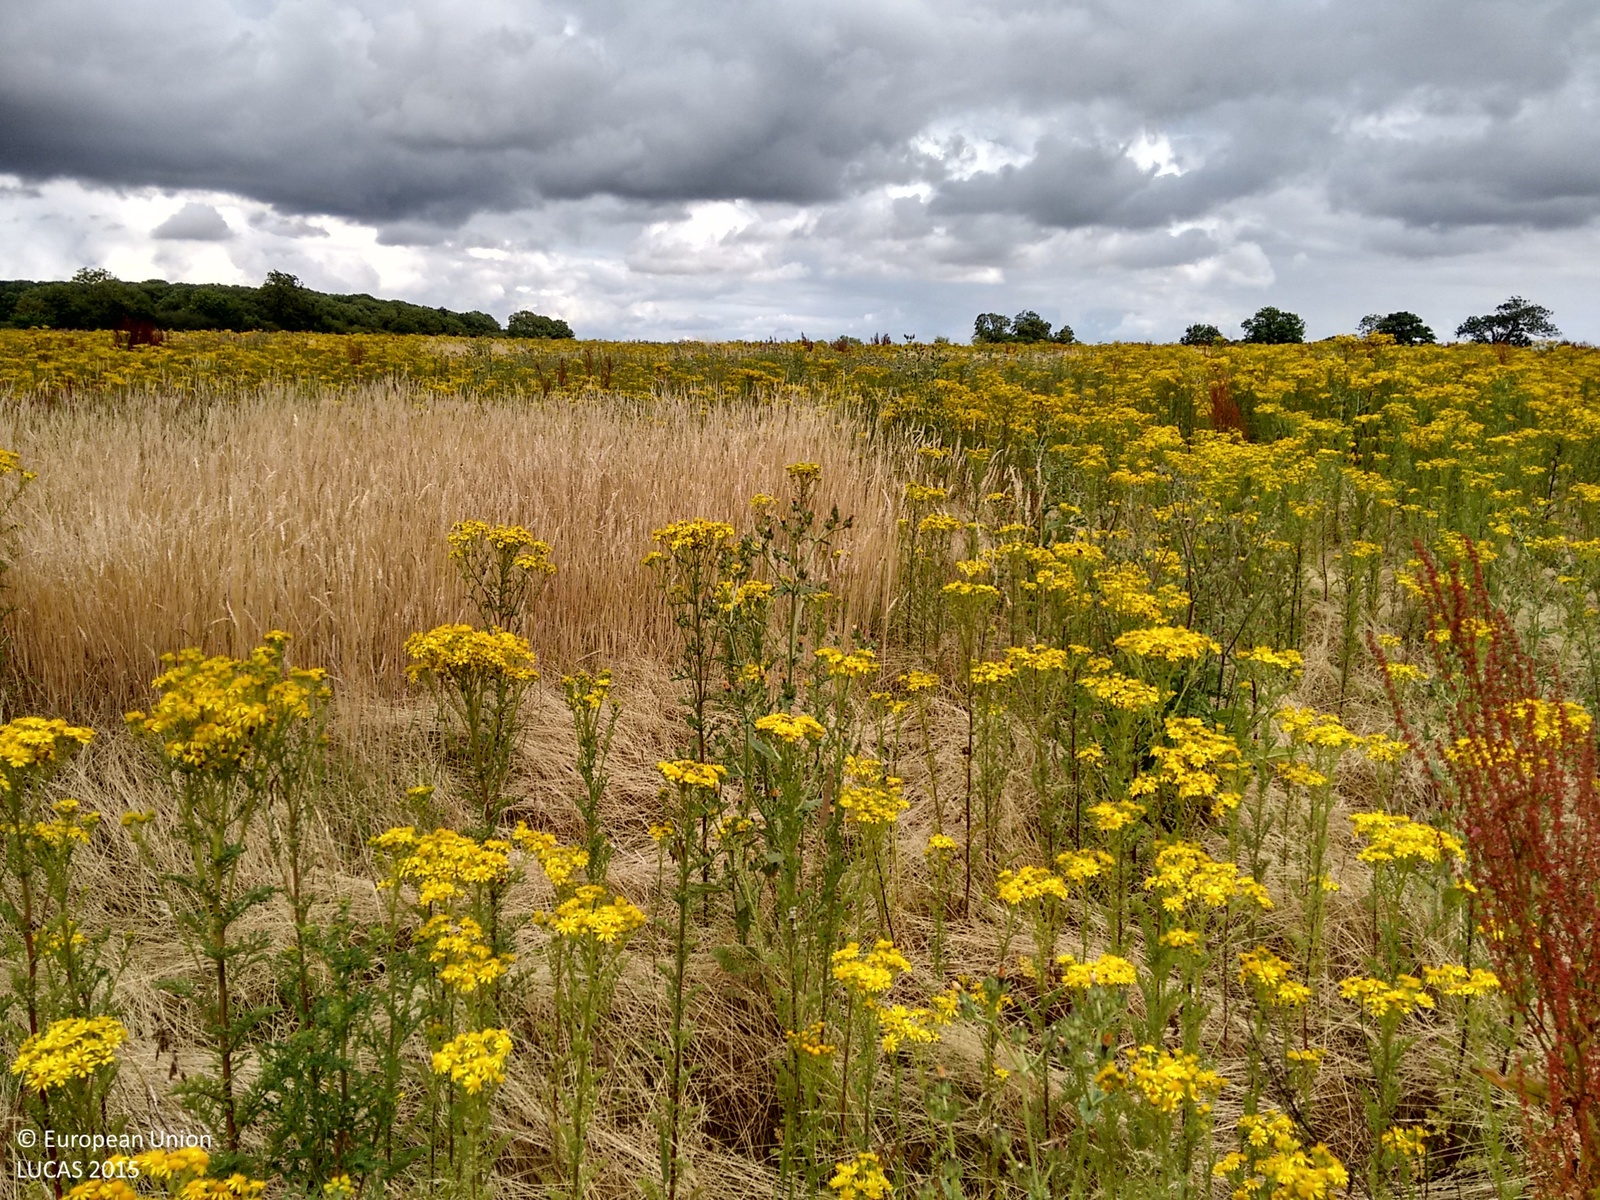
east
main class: Grassland
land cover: Spontaneously vegetated surfaces
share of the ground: > 75 %
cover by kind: herbaceous plants 100 %
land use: Fallow land
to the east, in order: Spontaneously vegetated surfaces
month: July
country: GB
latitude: 52.7884
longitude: -0.8218
